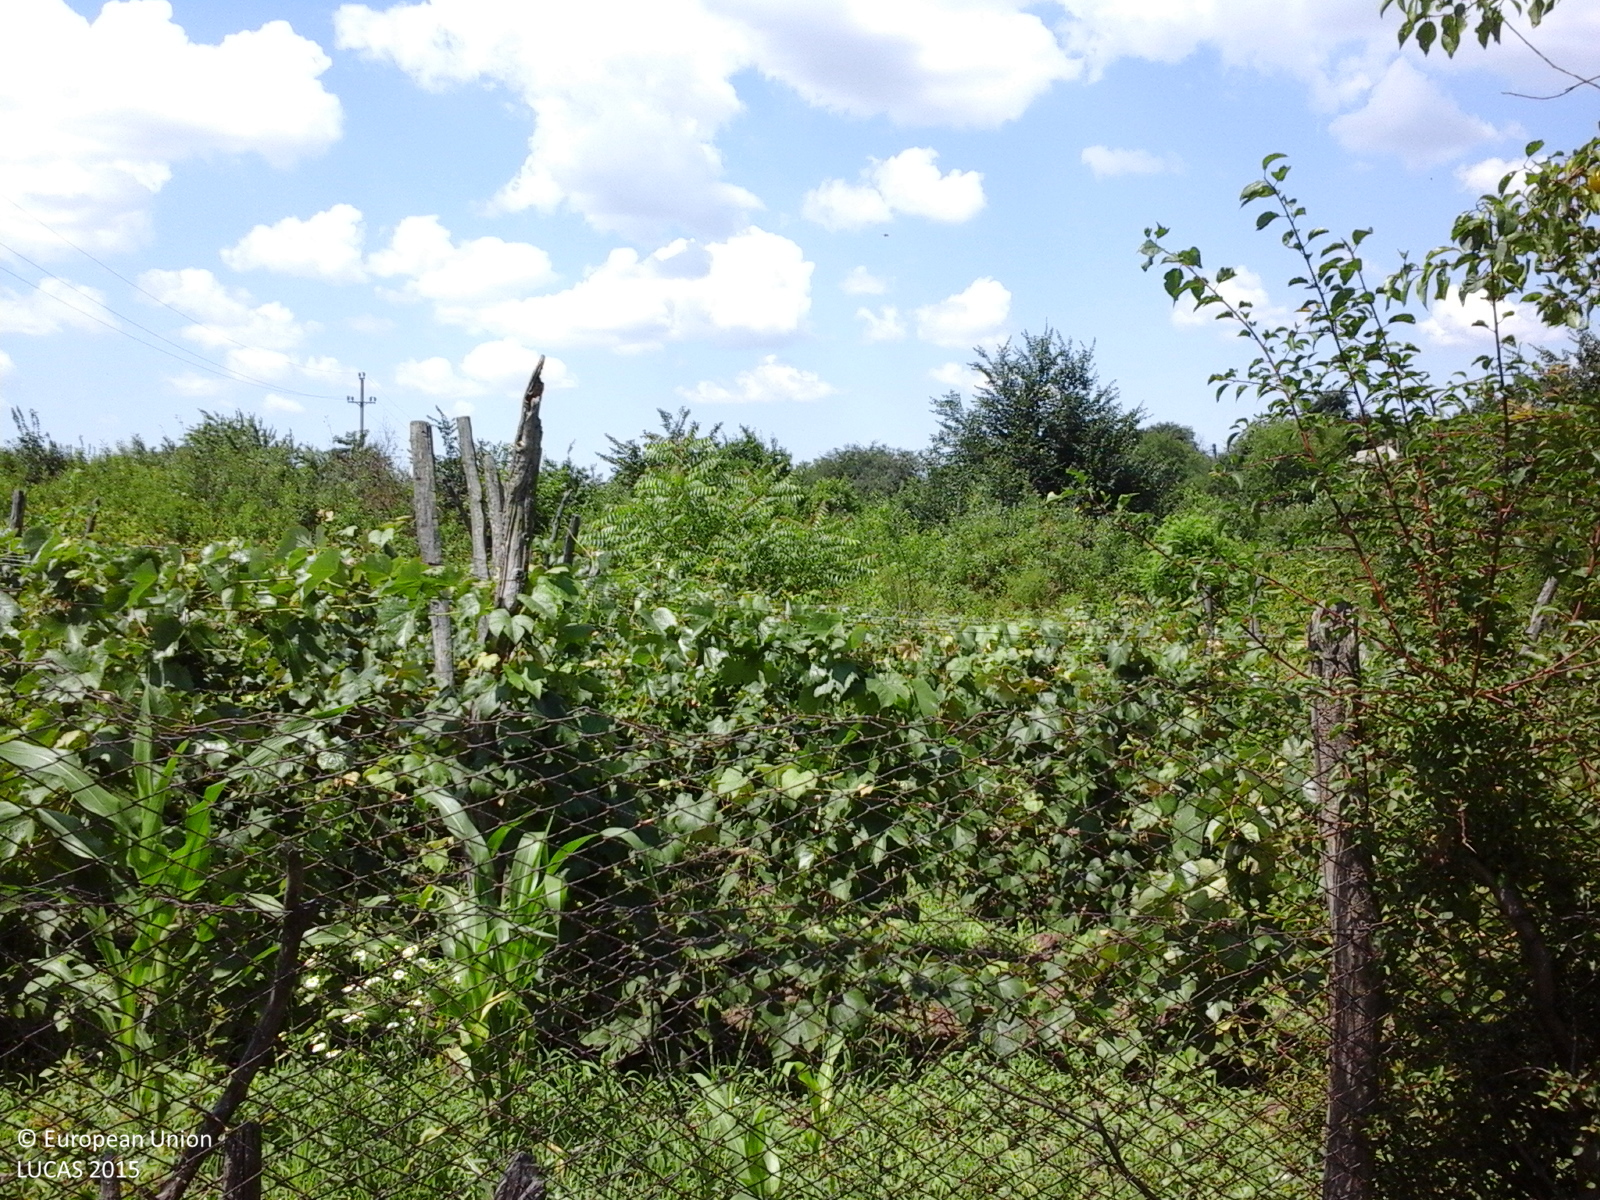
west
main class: Cropland
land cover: Vineyards
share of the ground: 50 - 75 %
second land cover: Grassland without tree/shrub cover
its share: 25 - 50 %
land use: Agriculture (excluding fallow land and kitchen gardens)
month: July
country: RO
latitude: 44.2366
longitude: 24.7861
